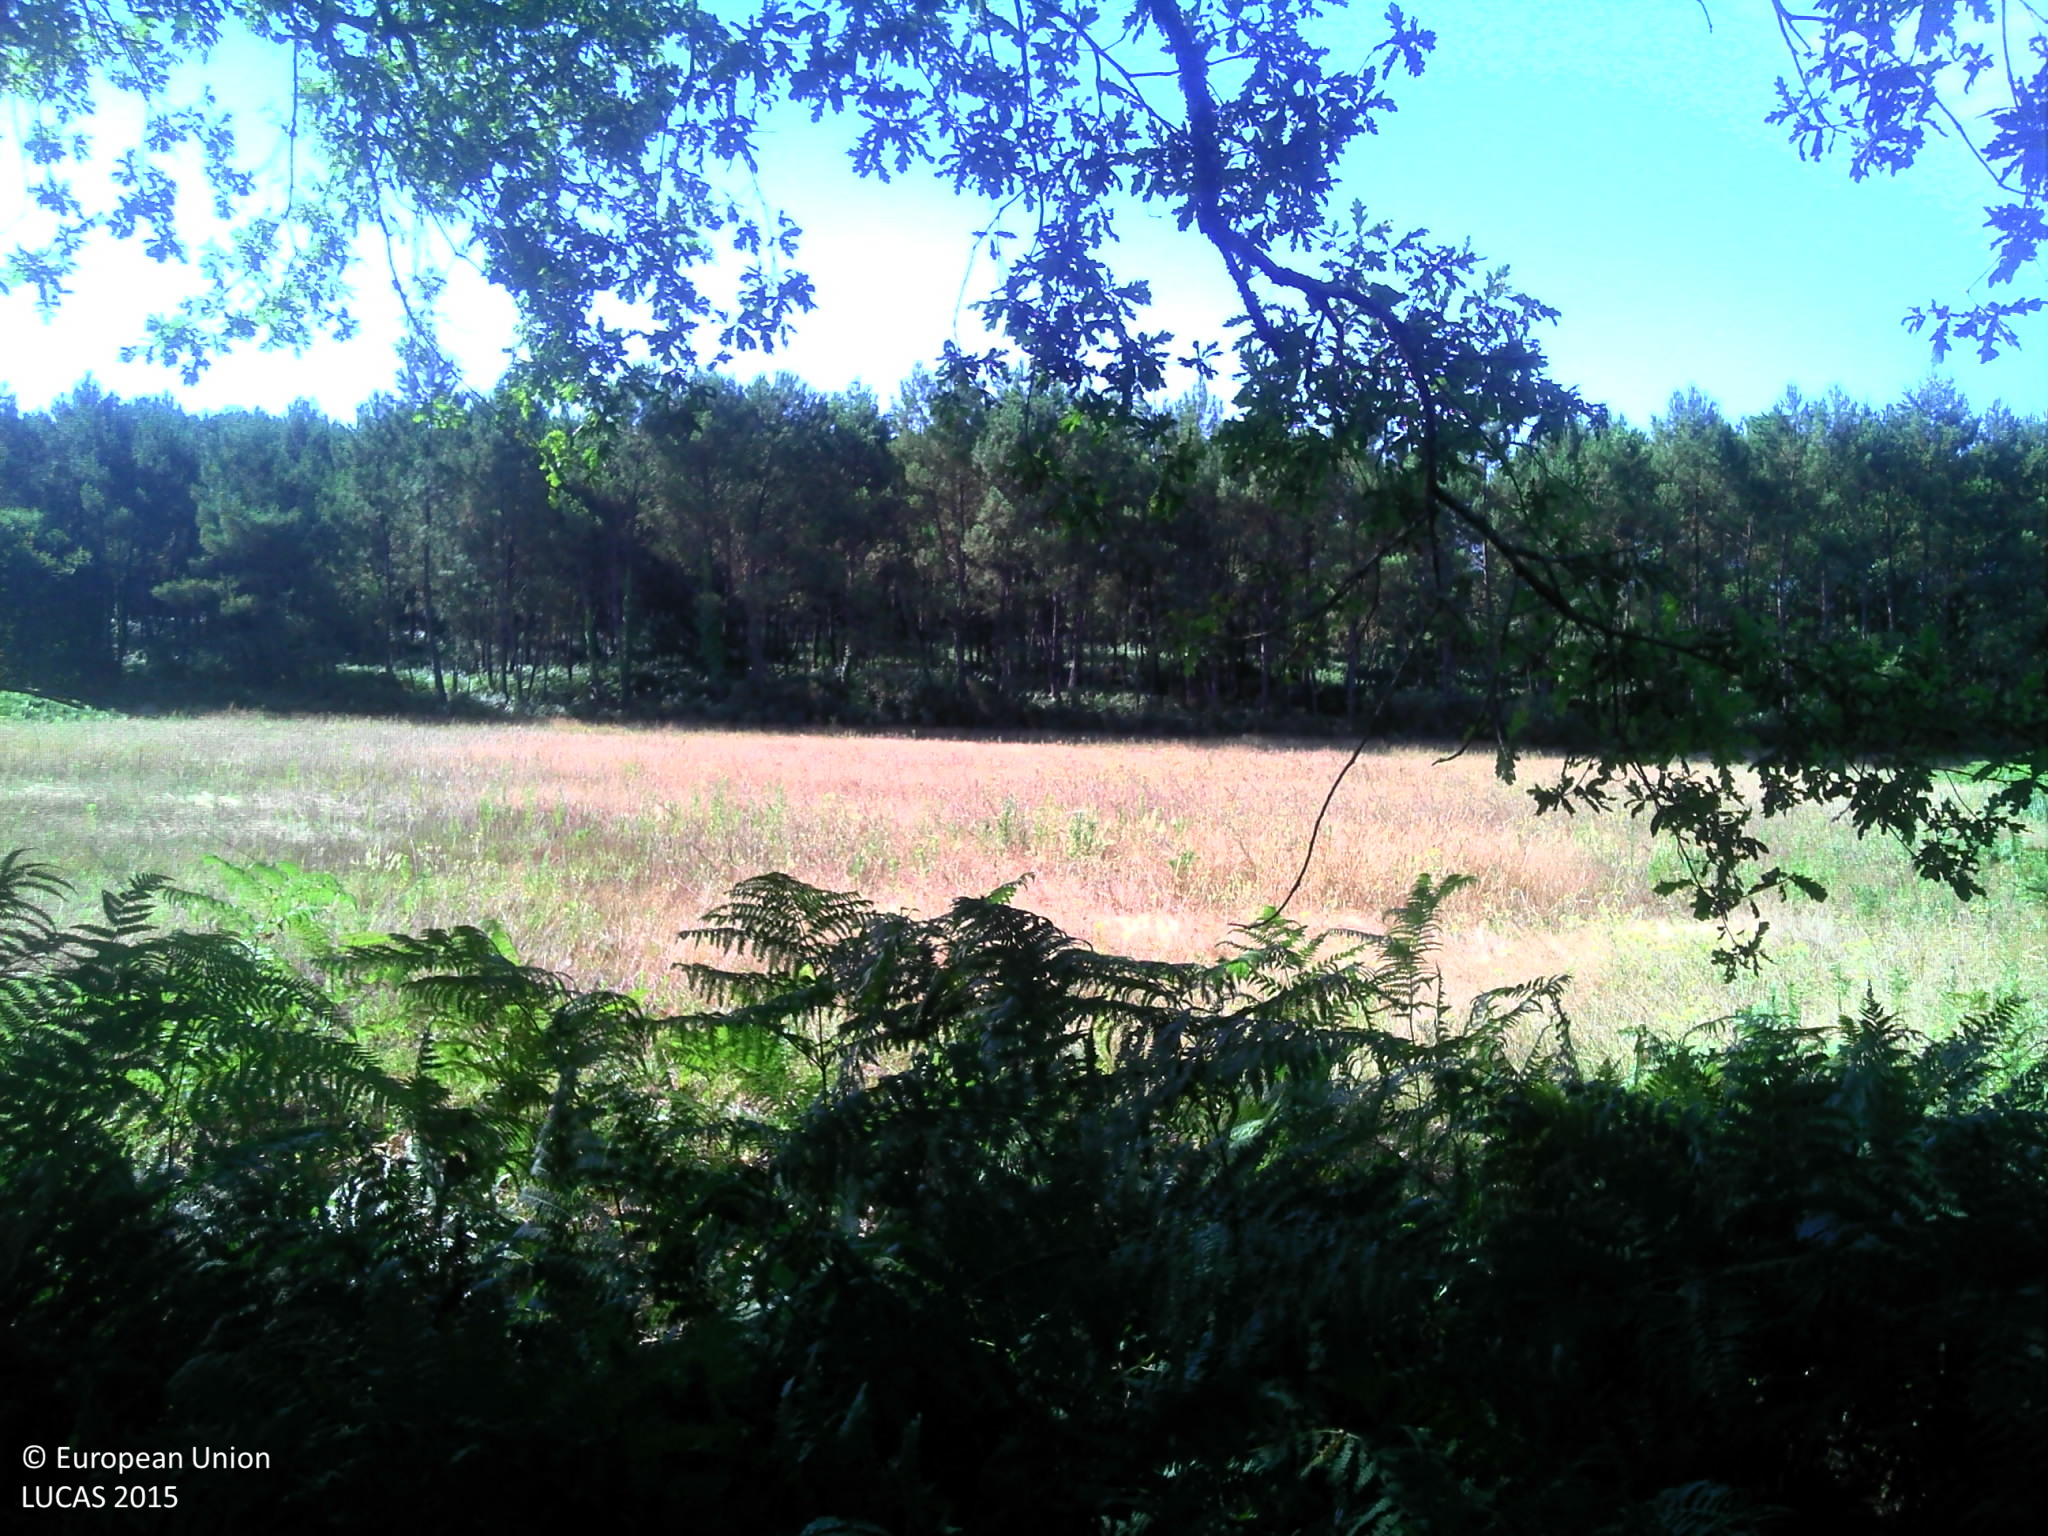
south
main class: Woodland
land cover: Broadleaved woodland
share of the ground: > 75 %
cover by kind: broadleaved forest trees 50 %, herbaceous plants 40 %, shrubs 10 %
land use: Semi-natural and natural areas not in use
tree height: > 5 m
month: July
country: FR
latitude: 43.8988
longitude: -0.5825
